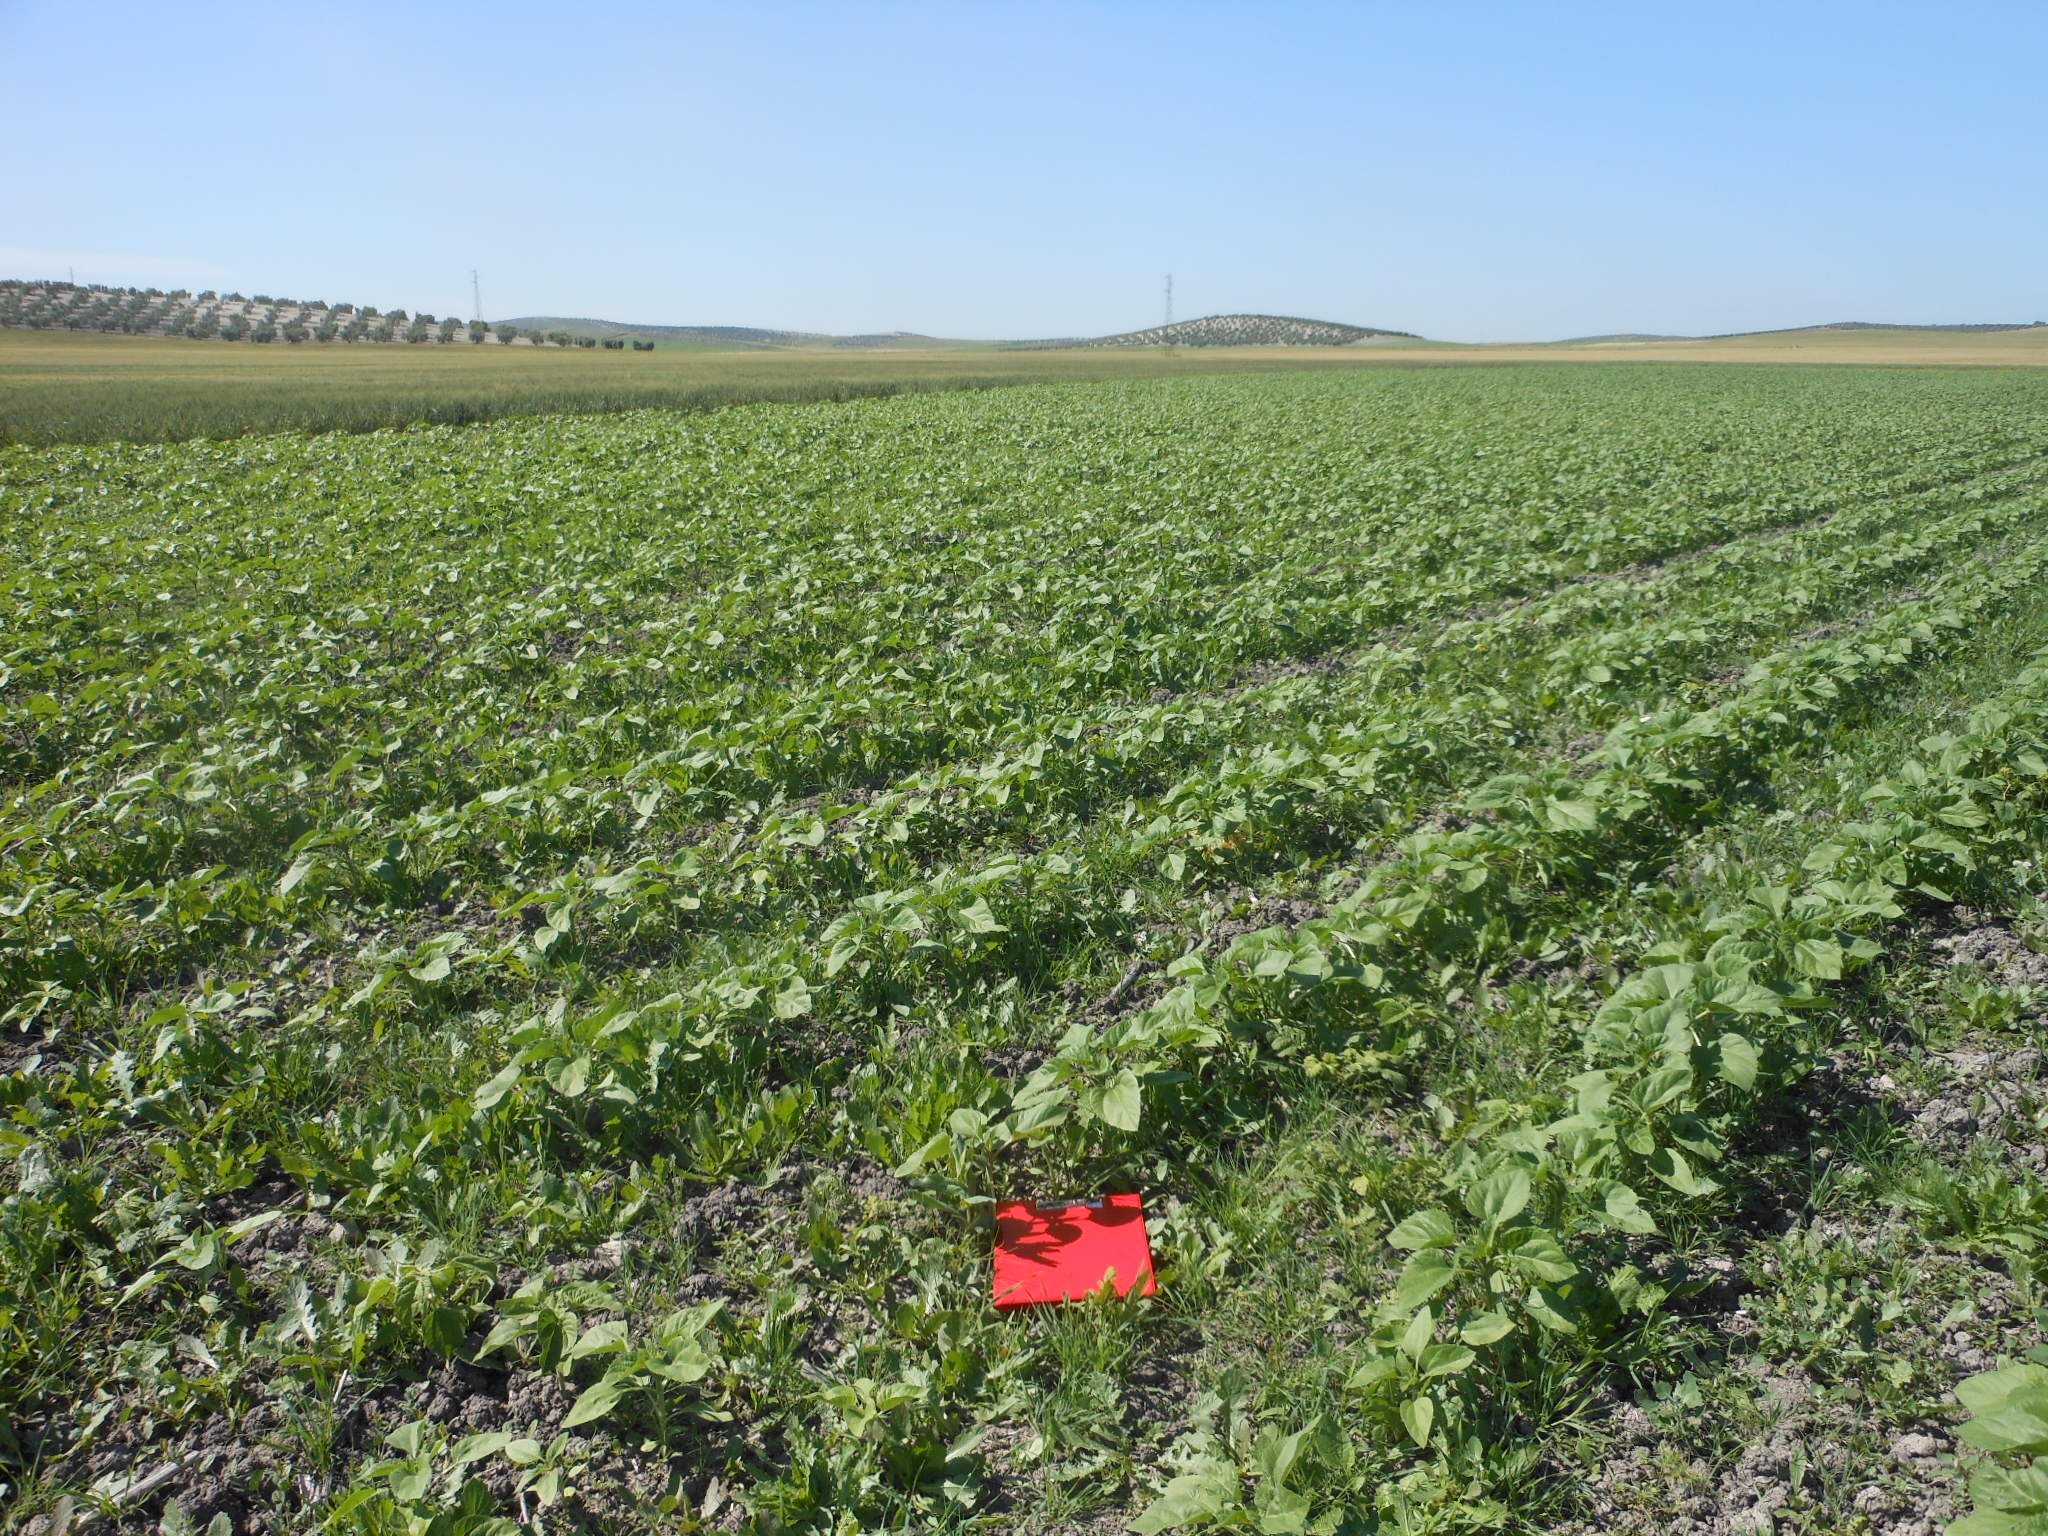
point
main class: Cropland
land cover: Sunflower
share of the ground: 25 - 50 %
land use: Agriculture (excluding fallow land and kitchen gardens)
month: April
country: ES
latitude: 37.3751
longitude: -5.4751
